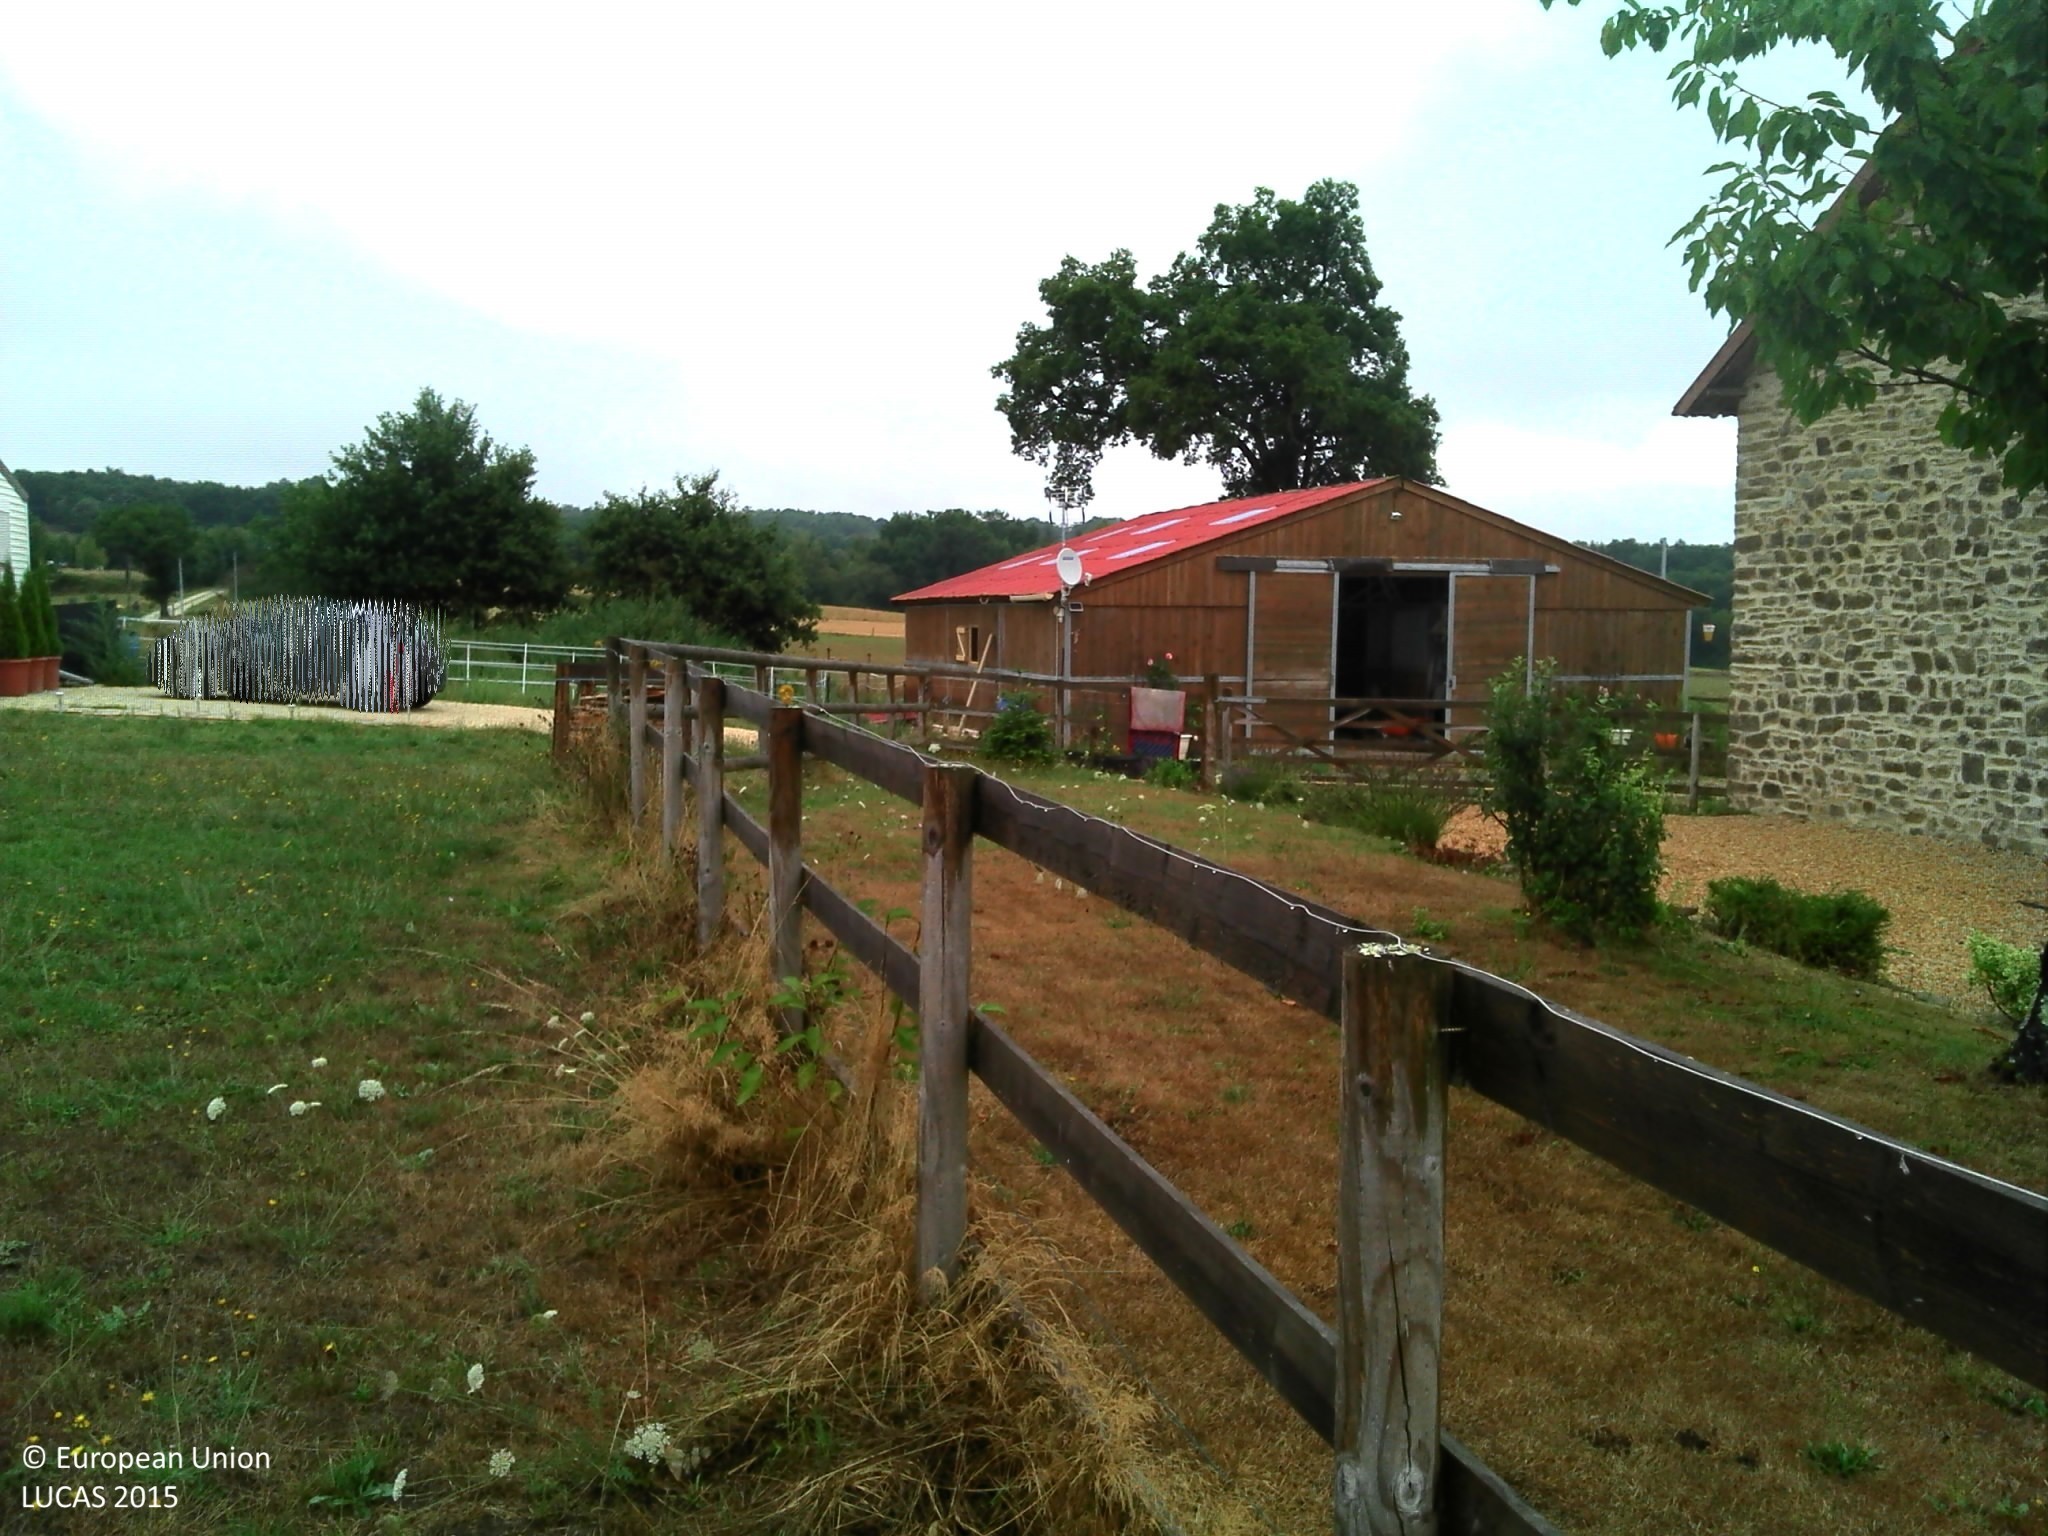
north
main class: Grassland
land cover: Grassland without tree/shrub cover
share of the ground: > 75 %
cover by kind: herbaceous plants 85 %, lichens and mosses 10 %, unconsolidated bare surface 5 %
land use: Agriculture (excluding fallow land and kitchen gardens)
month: August
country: FR
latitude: 45.4838
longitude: 1.0222
